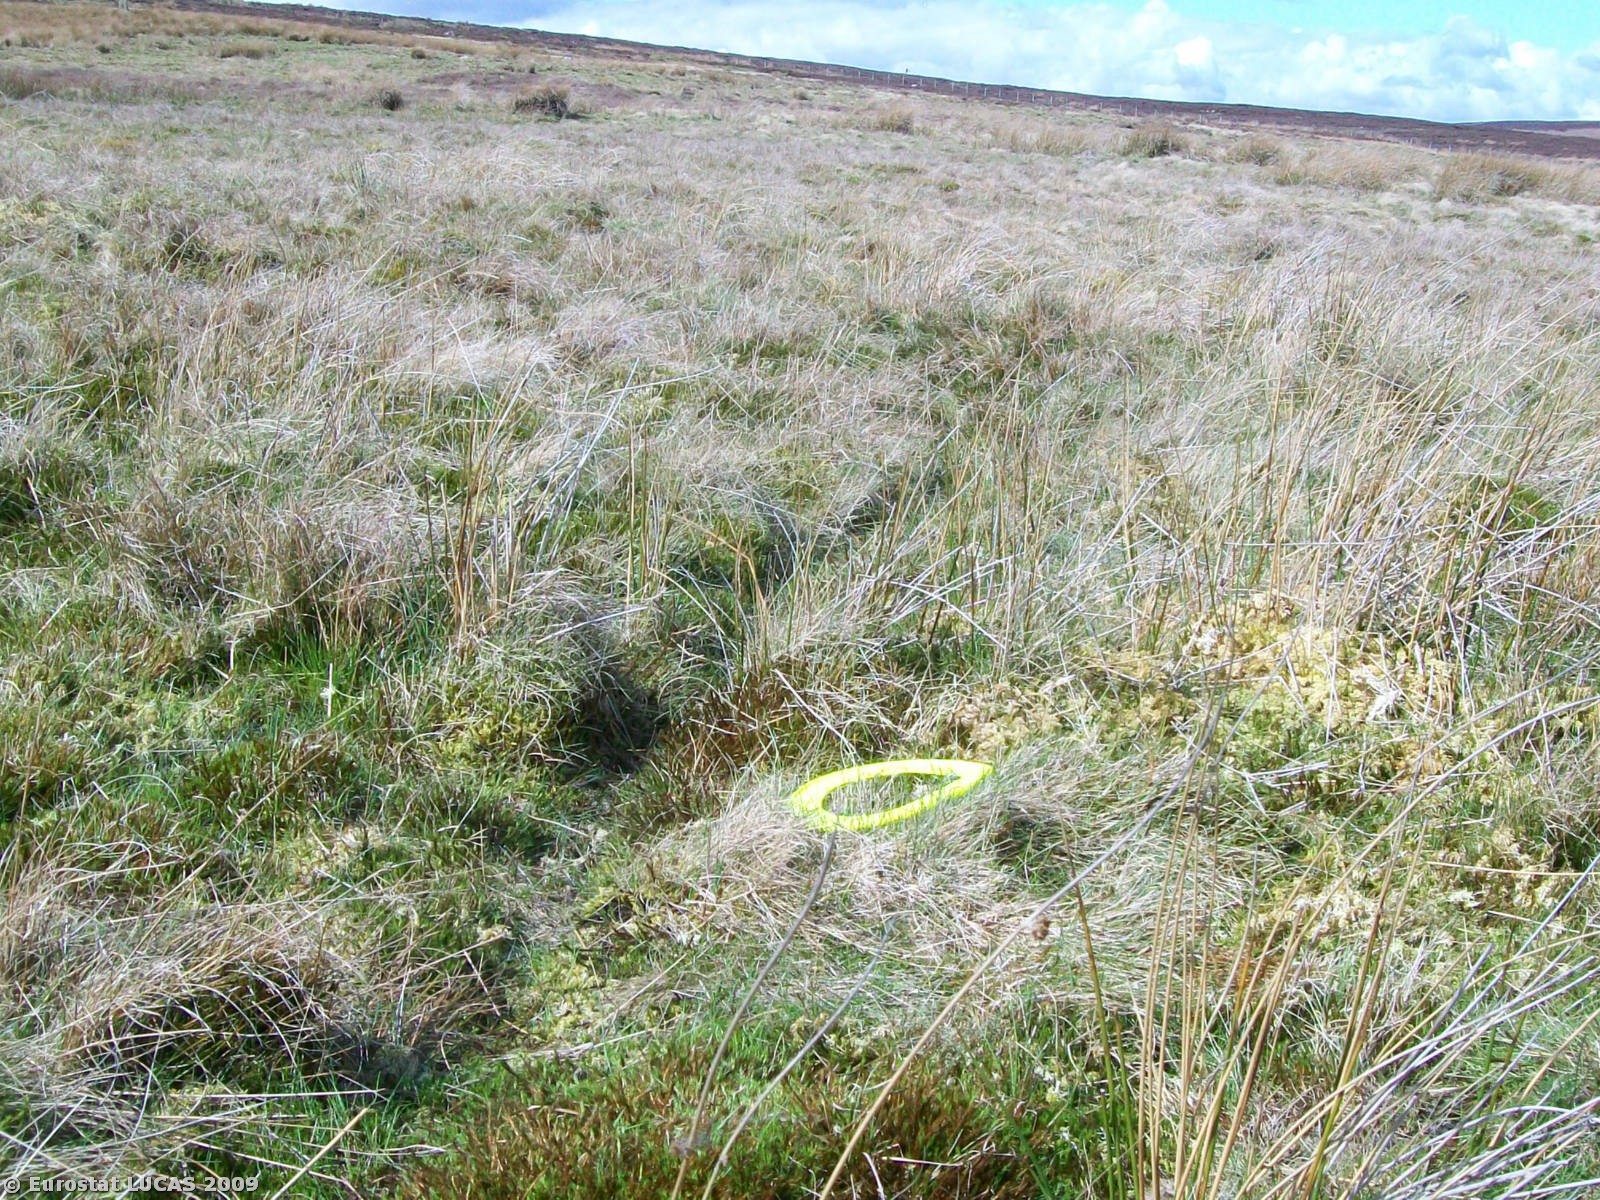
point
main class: Shrubland
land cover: Shrubland without tree cover
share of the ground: > 75 %
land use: Agriculture (excluding fallow land and kitchen gardens)
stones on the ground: < 10 %
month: April
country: GB
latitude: 54.8723
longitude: -2.0392
